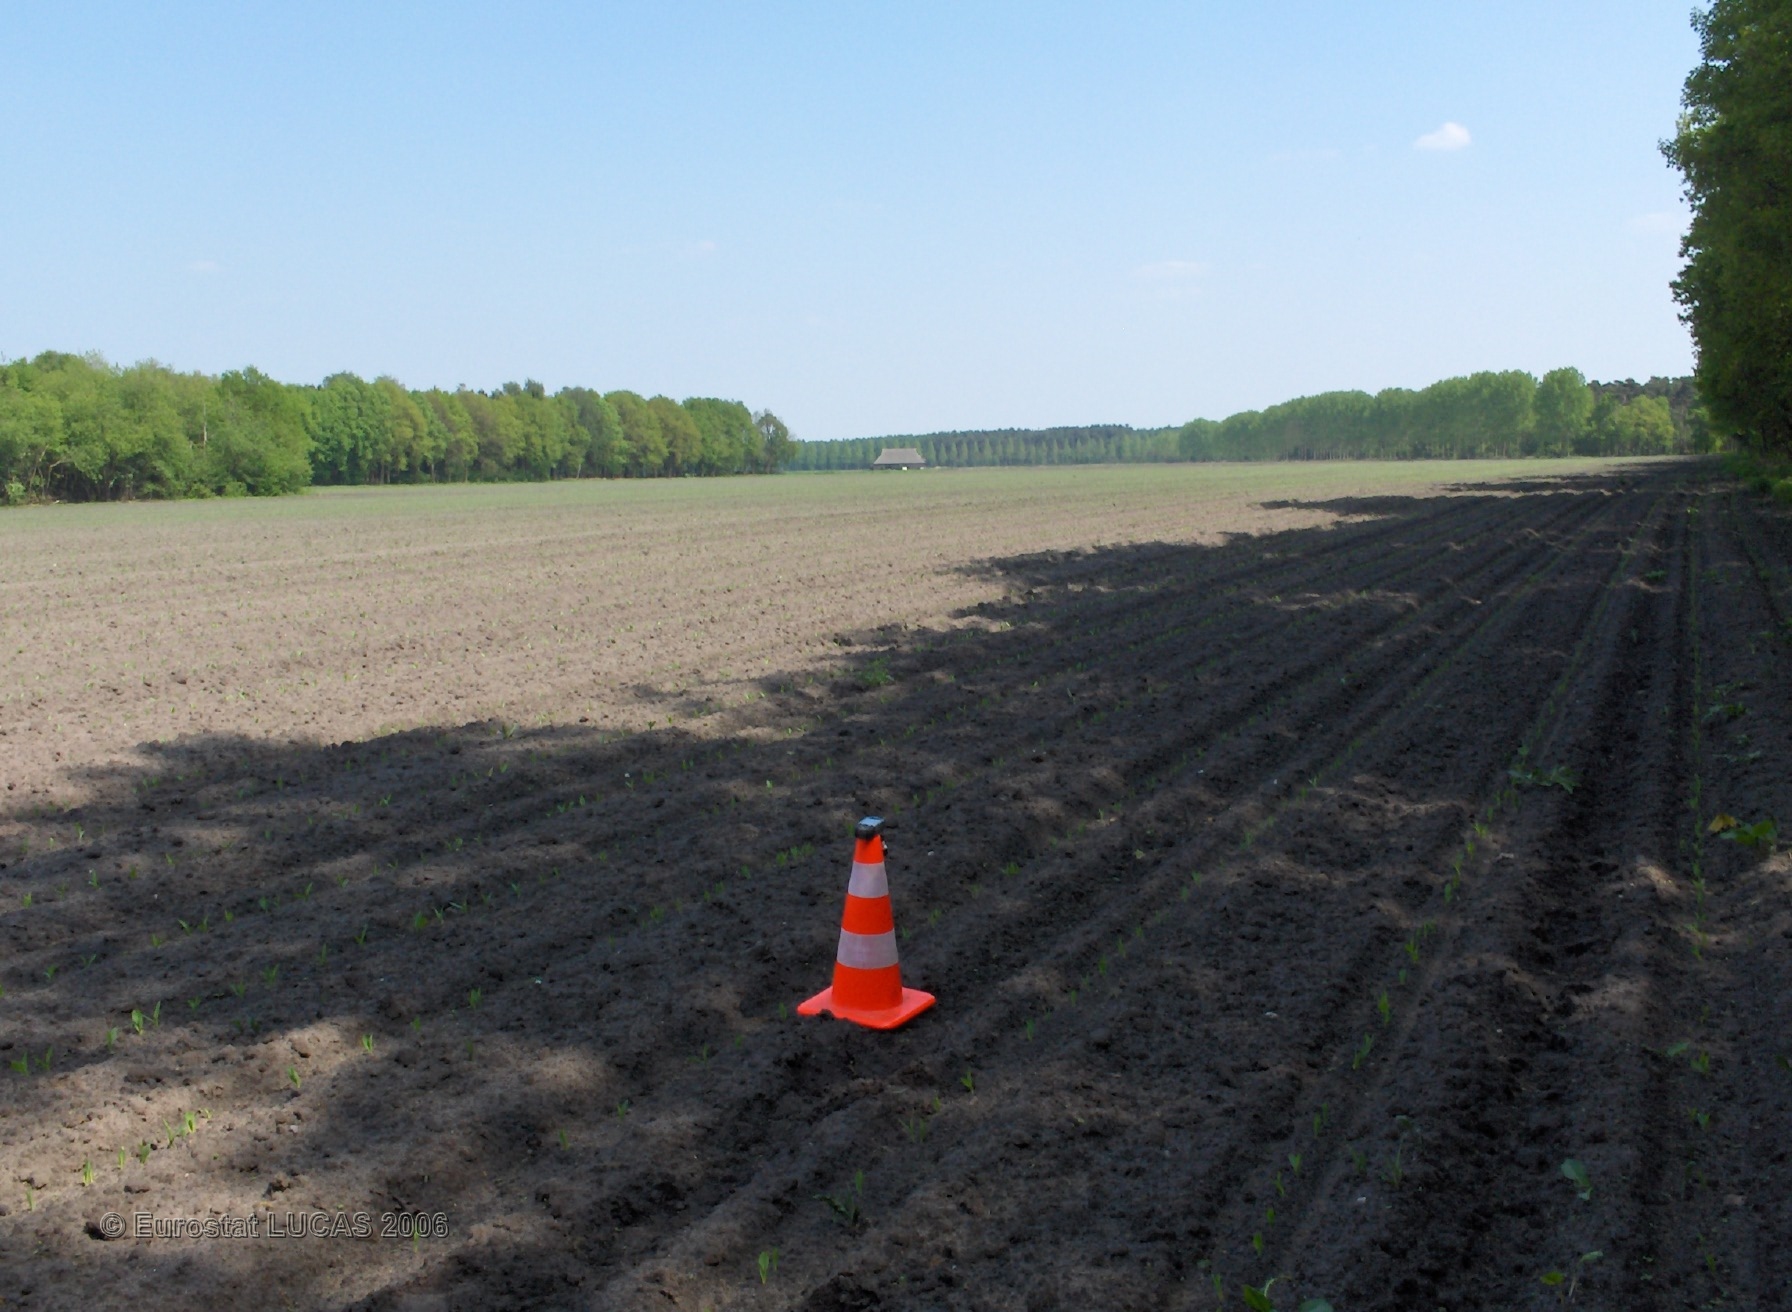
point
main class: Cropland
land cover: Maize
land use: Agriculture (excluding fallow land and kitchen gardens)
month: May
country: BE
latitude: 51.2897
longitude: 5.1938
